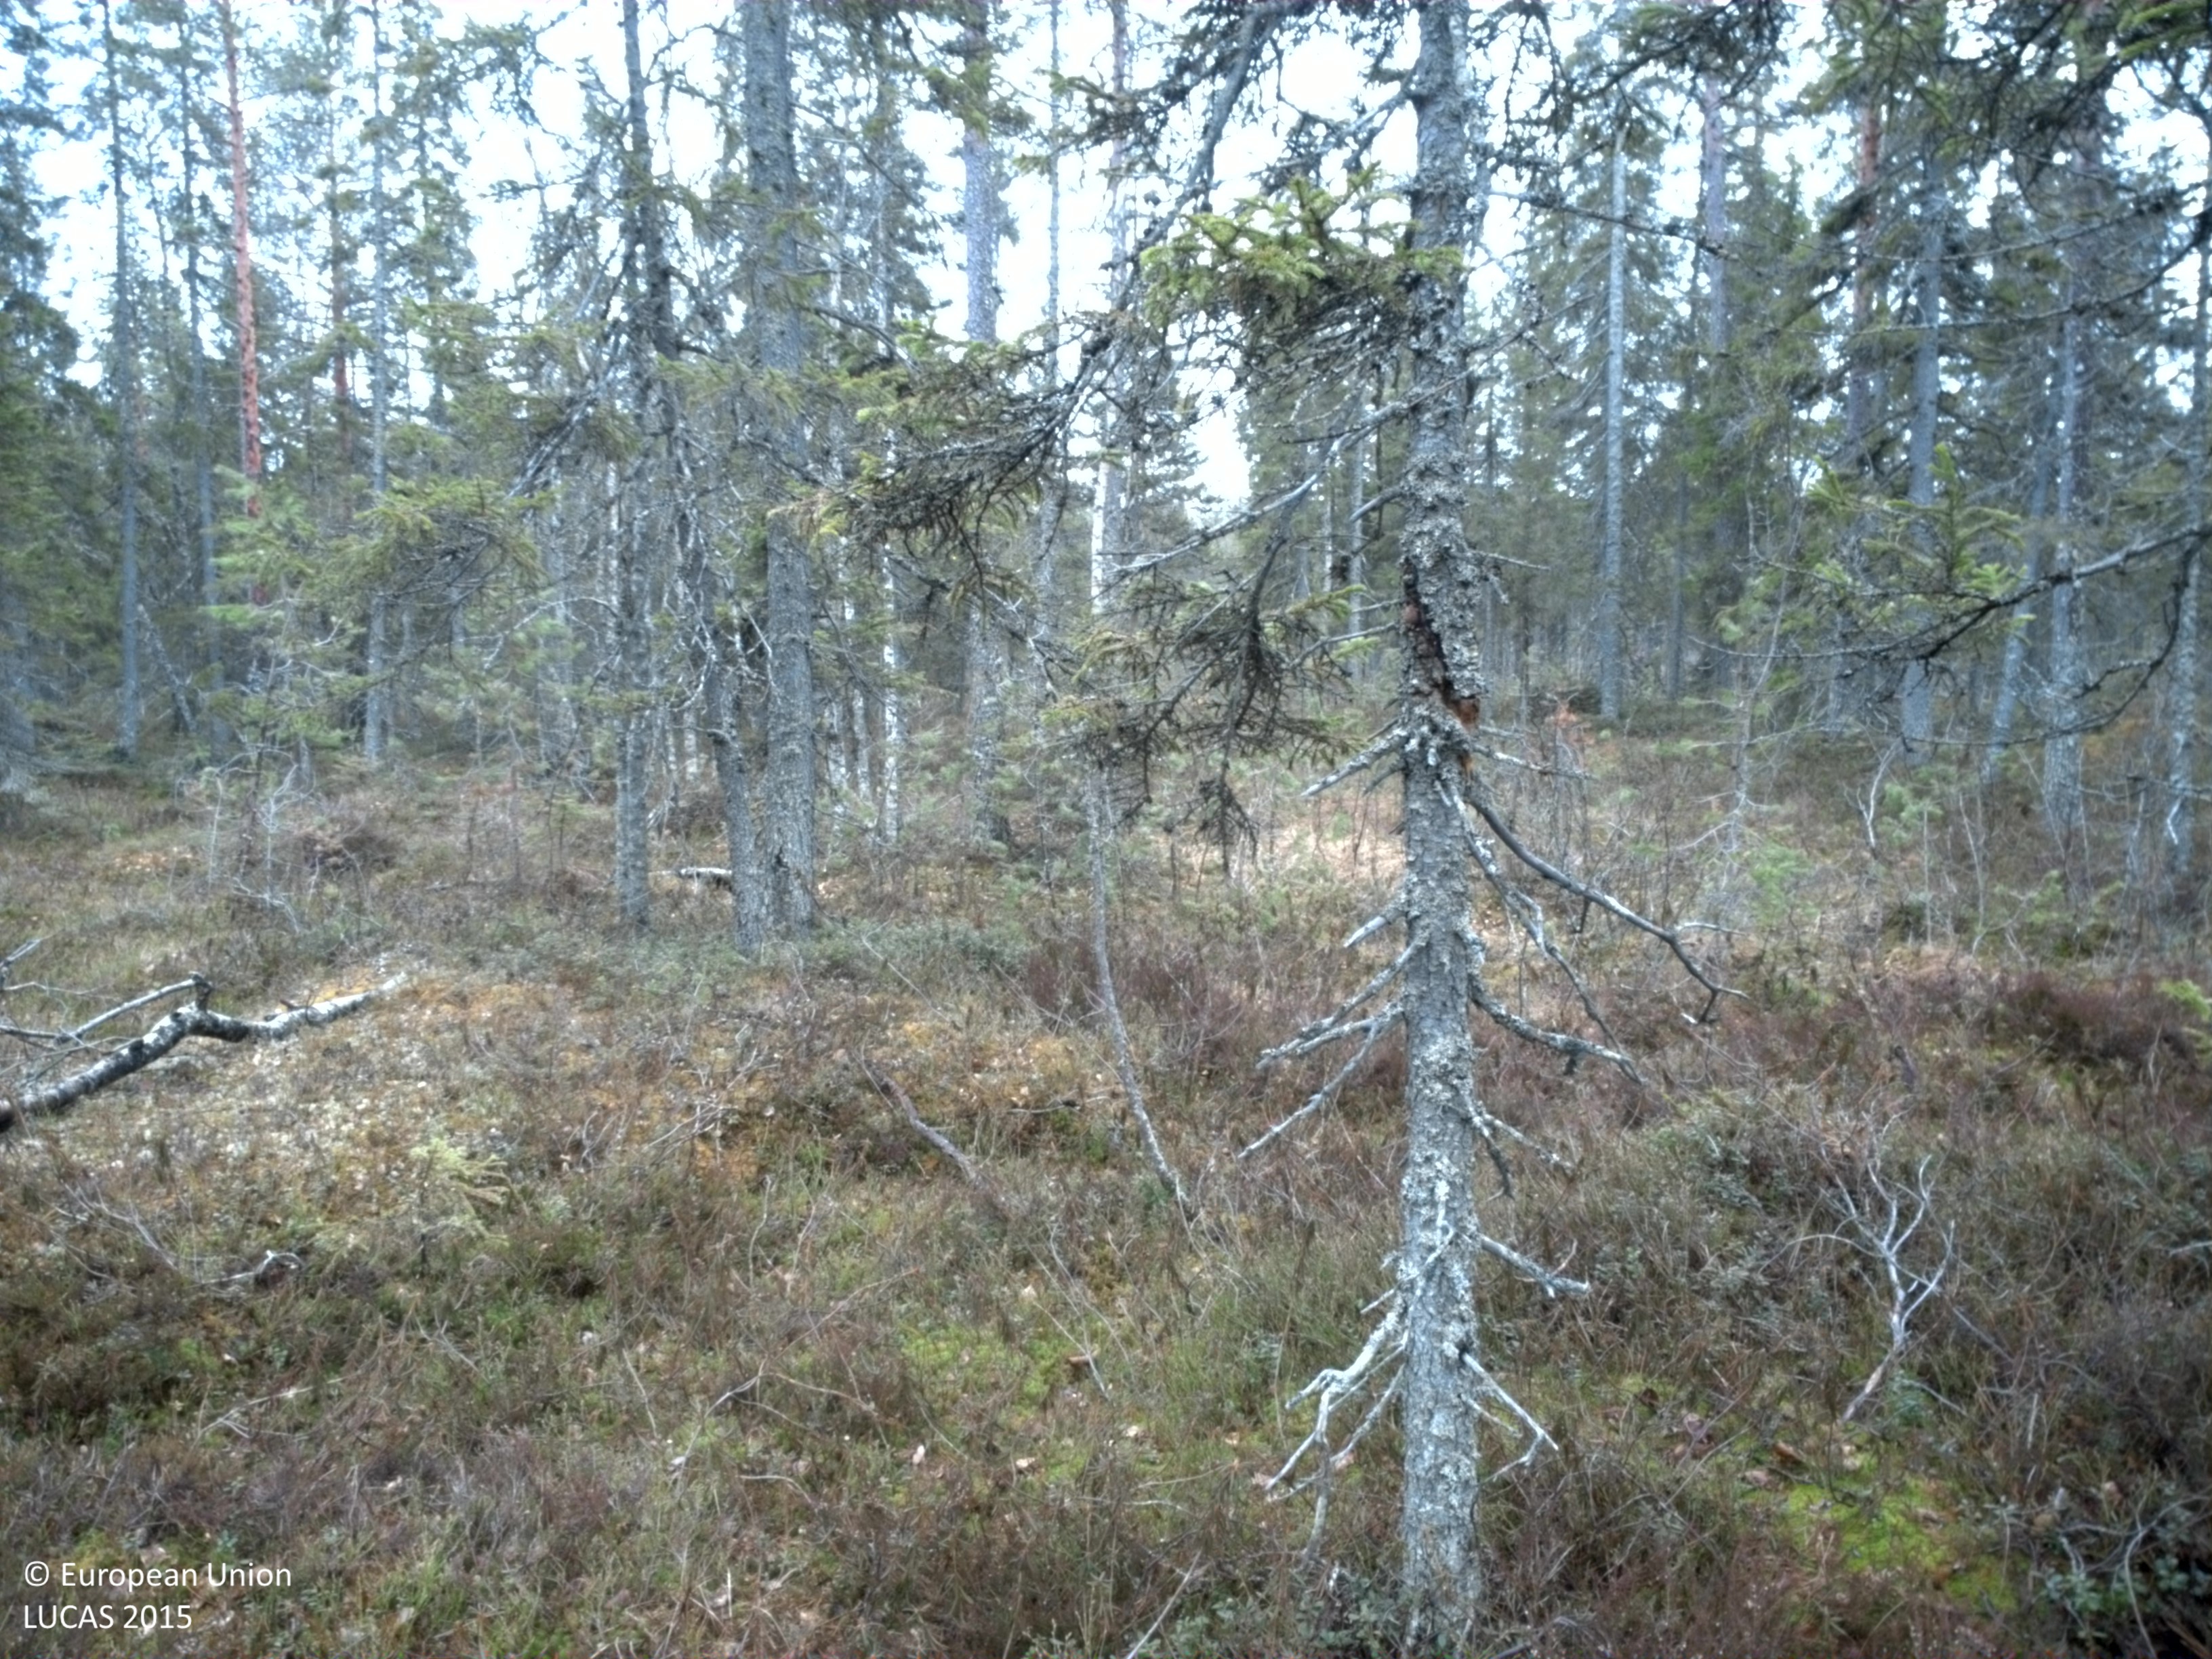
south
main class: Woodland
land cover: Other coniferous woodland
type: boreal forest
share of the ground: > 75 %
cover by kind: coniferous forest trees 75 %, shrubs 15 %, broadleaved forest trees 5 %, lichens and mosses 5 %
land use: Forestry
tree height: > 5 m
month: May
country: SE
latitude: 65.8680
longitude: 22.9399
